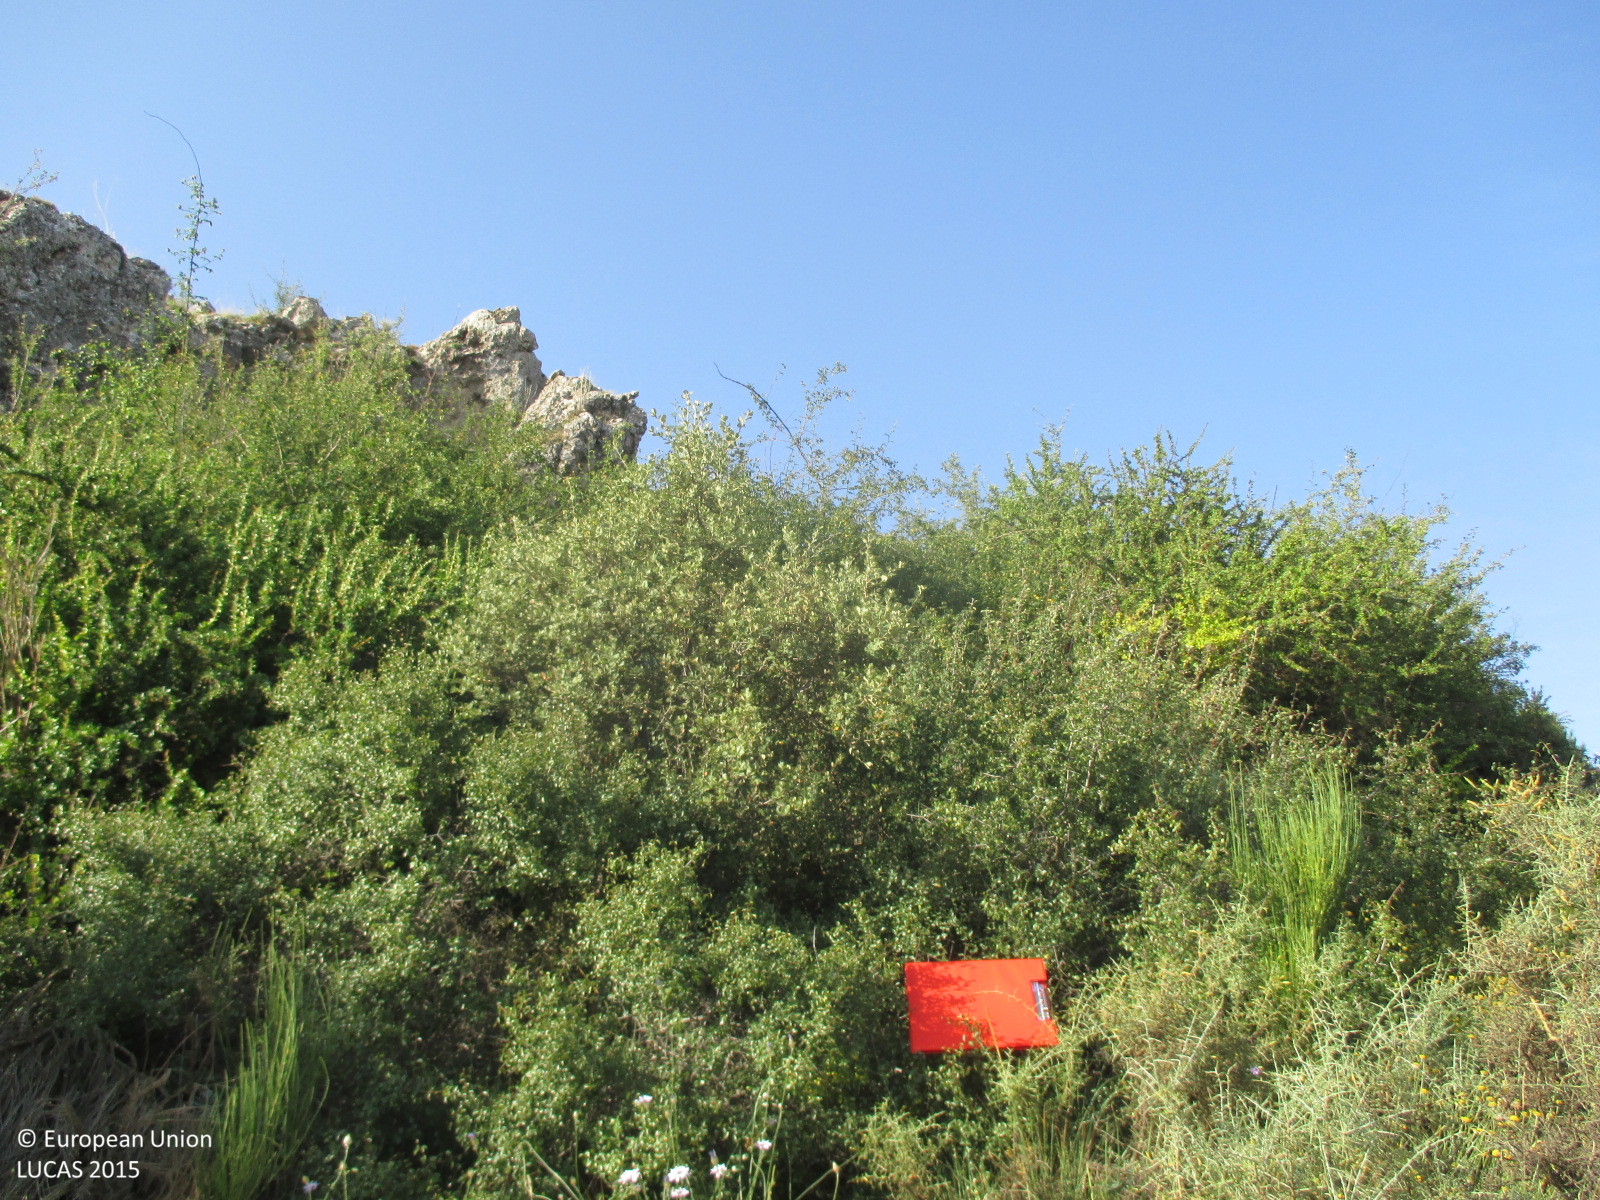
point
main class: Shrubland
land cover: Shrubland without tree cover
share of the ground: > 75 %
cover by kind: shrubs 90 %, herbaceous plants 10 %
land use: Semi-natural and natural areas not in use
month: July
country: ES
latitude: 38.0856
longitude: -2.4087
